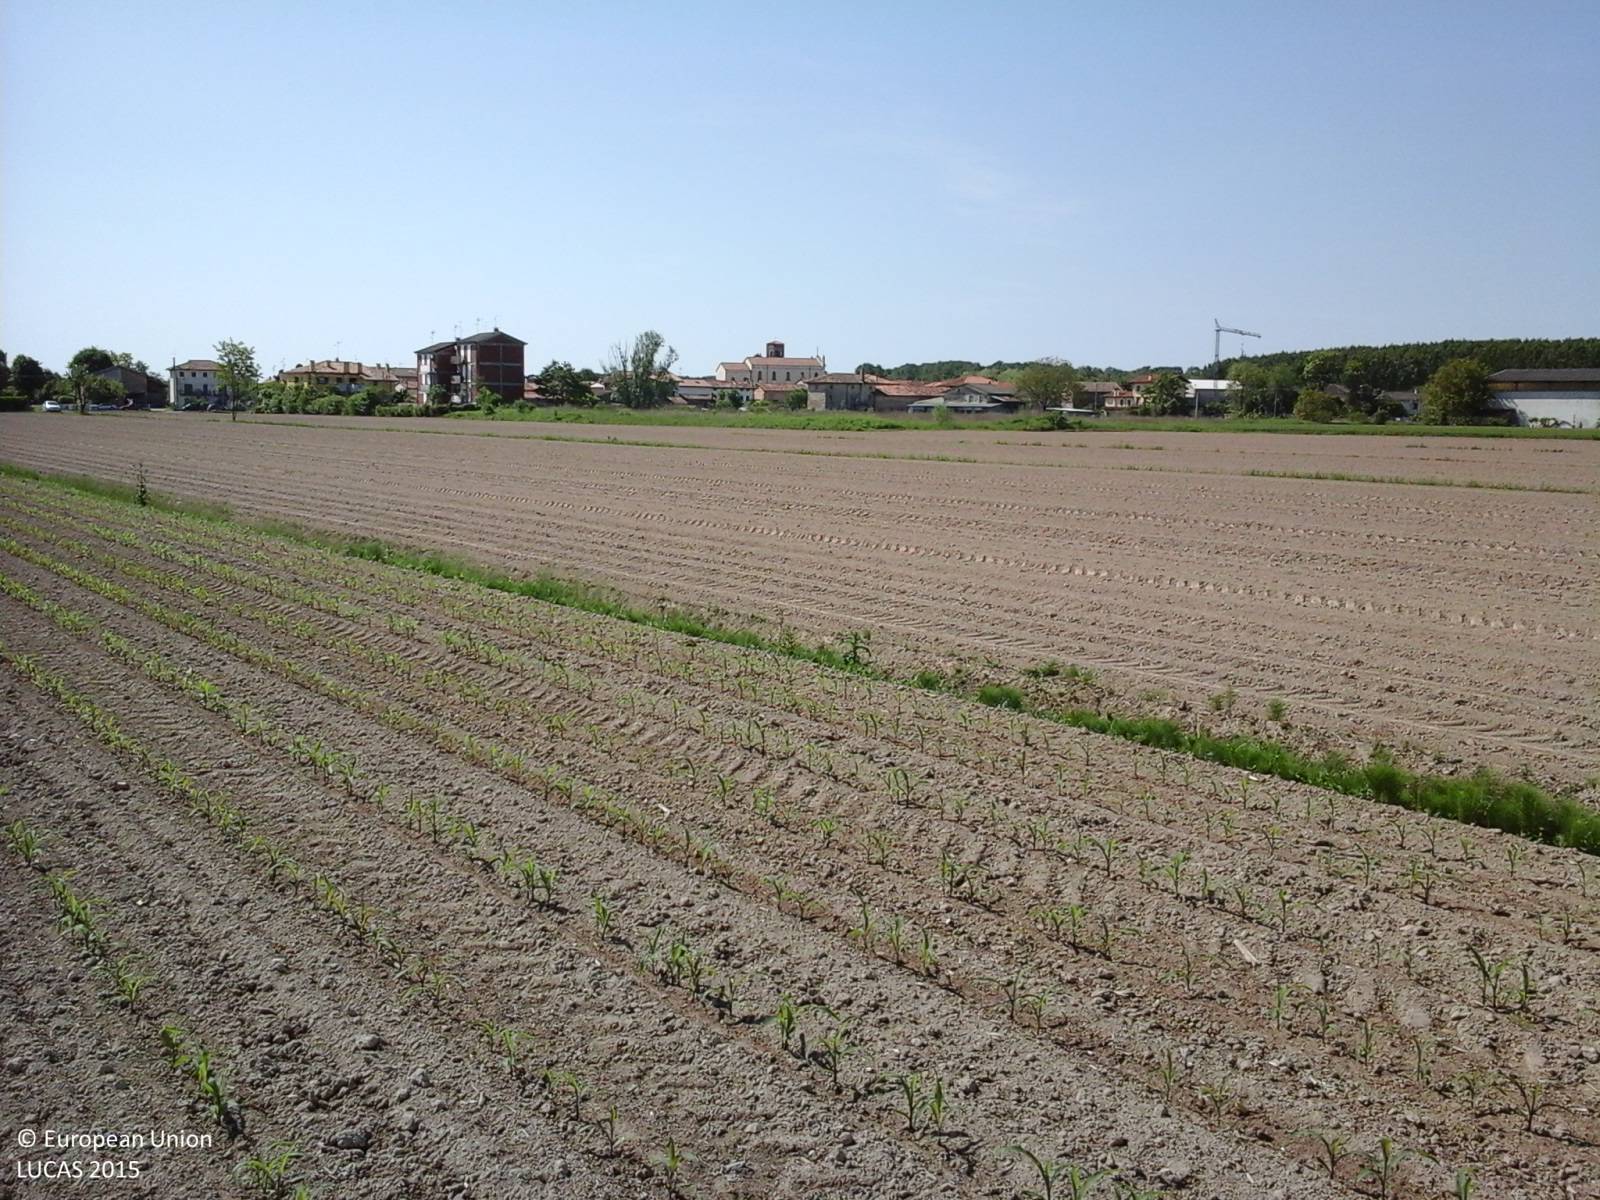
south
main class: Cropland
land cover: Maize
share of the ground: < 10 %
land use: Agriculture (excluding fallow land and kitchen gardens)
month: May
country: IT
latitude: 45.7498
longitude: 13.0169
